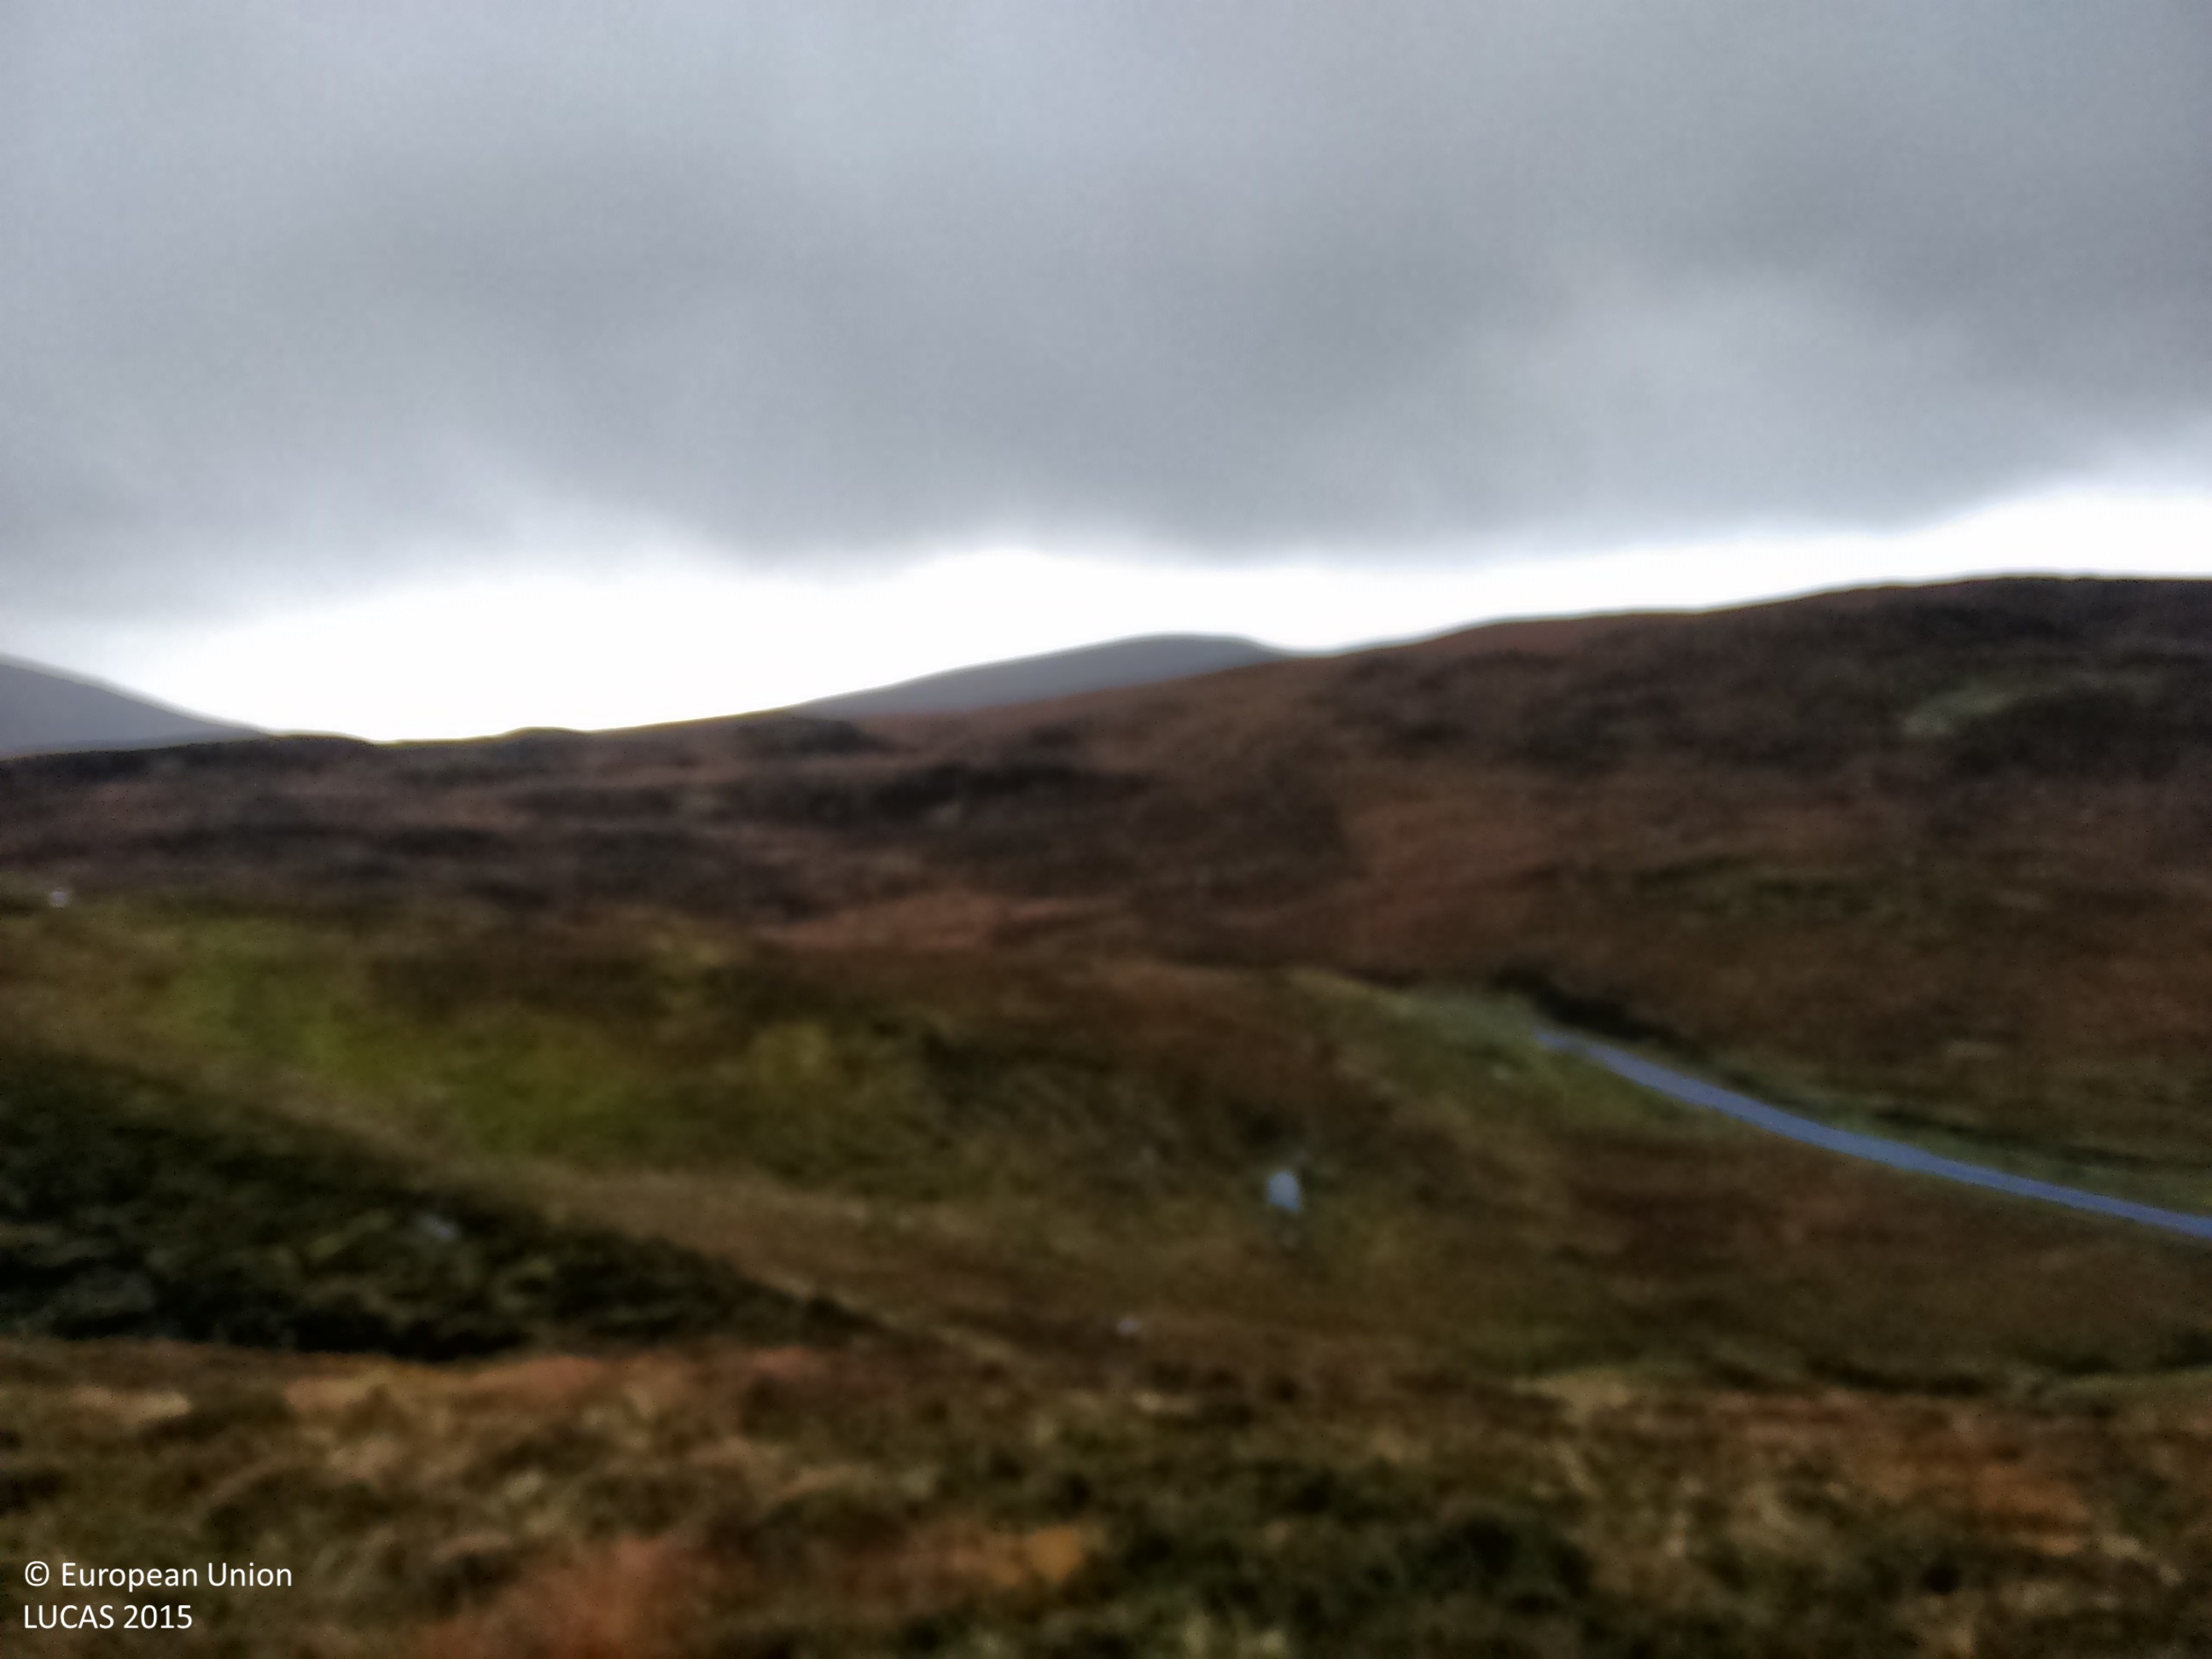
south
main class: Shrubland
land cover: Shrubland without tree cover
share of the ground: > 75 %
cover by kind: shrubs 40 %, herbaceous plants 40 %, lichens and mosses 20 %
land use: Agriculture (excluding fallow land and kitchen gardens)
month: November
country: IE
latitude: 54.6990
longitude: -8.7102
